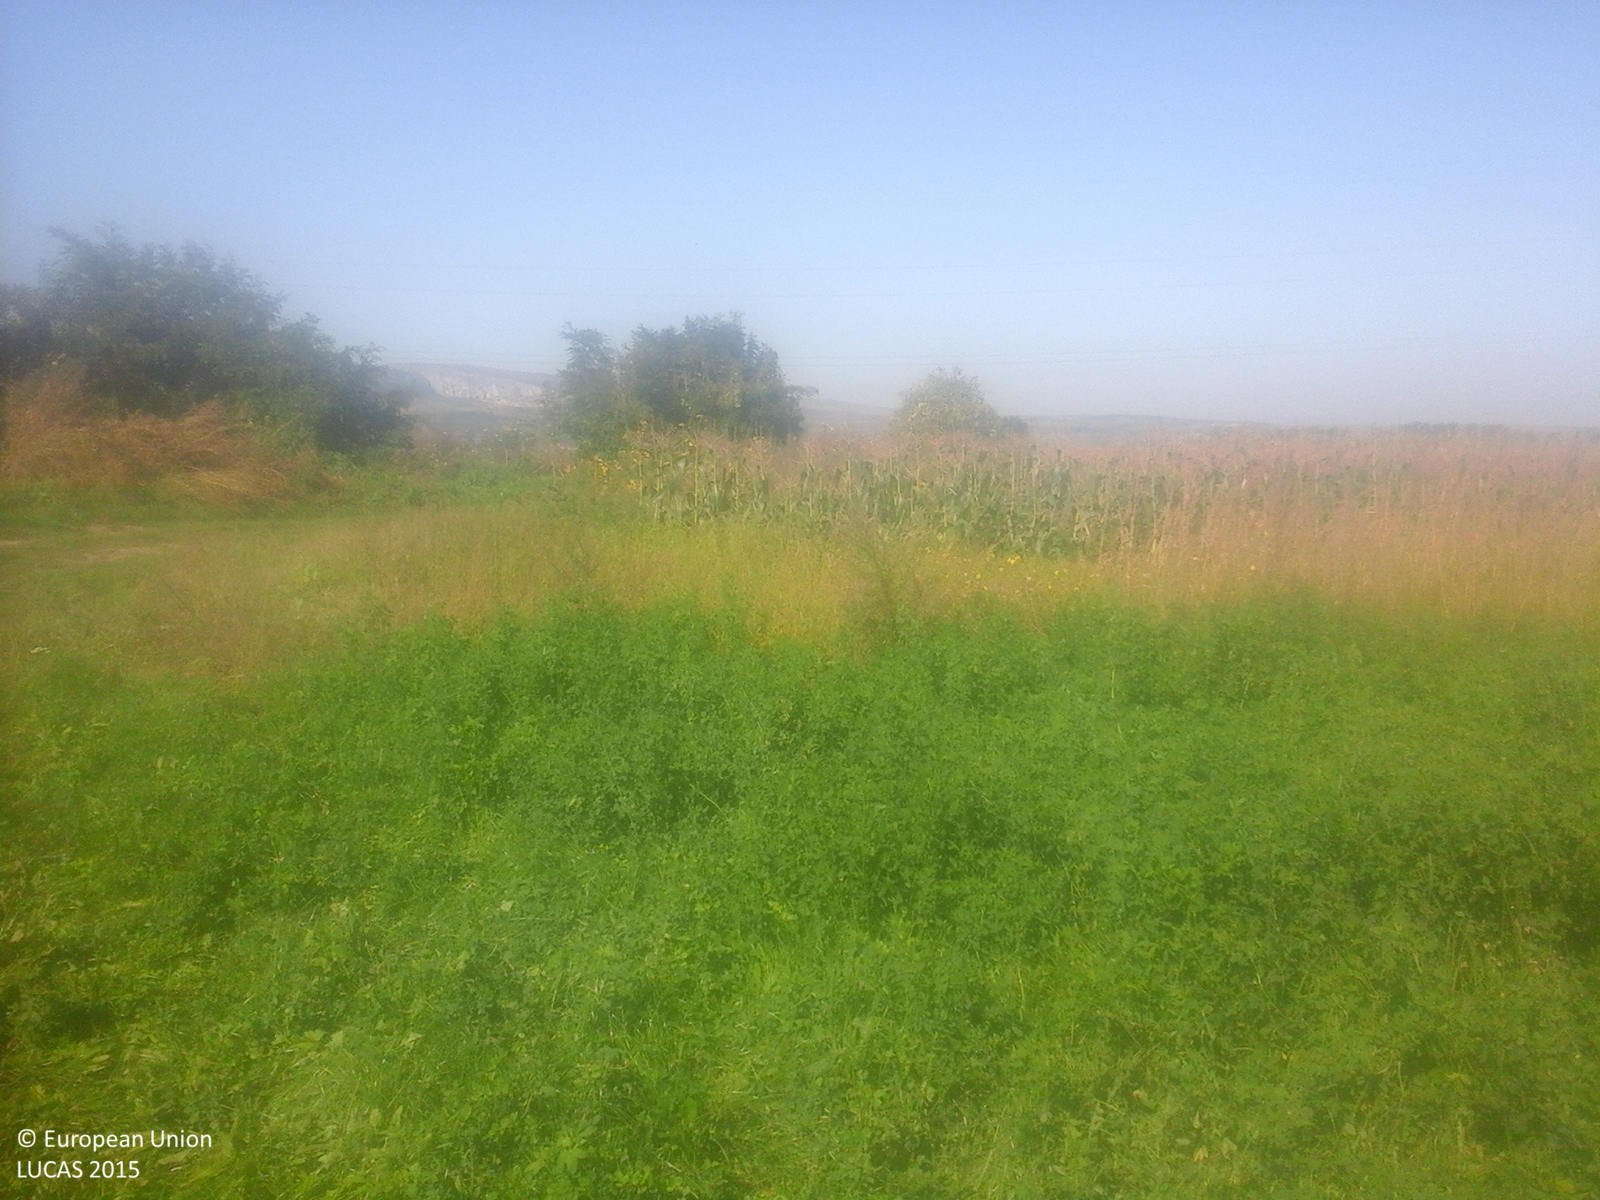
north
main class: Cropland
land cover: Lucerne
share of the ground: > 75 %
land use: Agriculture (excluding fallow land and kitchen gardens)
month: October
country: RO
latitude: 46.5034
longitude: 23.7151
